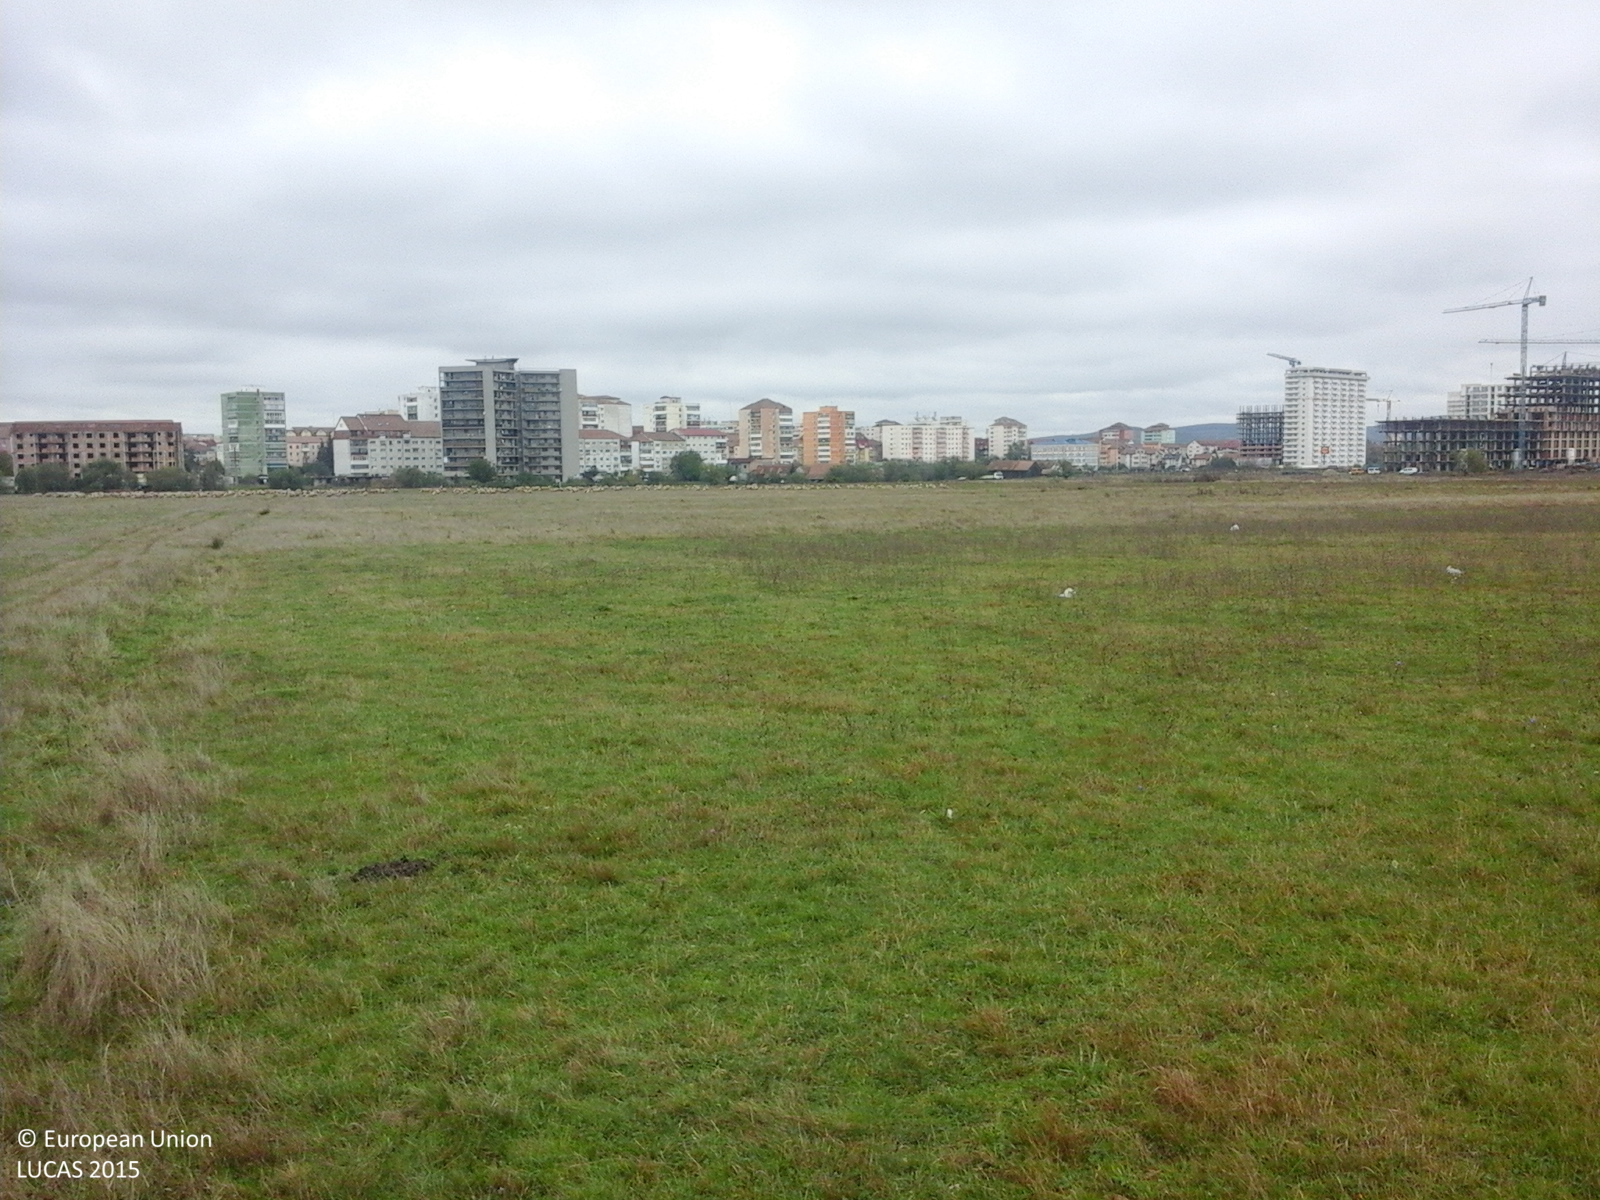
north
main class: Grassland
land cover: Grassland without tree/shrub cover
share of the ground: > 75 %
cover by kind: herbaceous plants 100 %
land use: Agriculture (excluding fallow land and kitchen gardens)
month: October
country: RO
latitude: 45.7695
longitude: 24.1555
